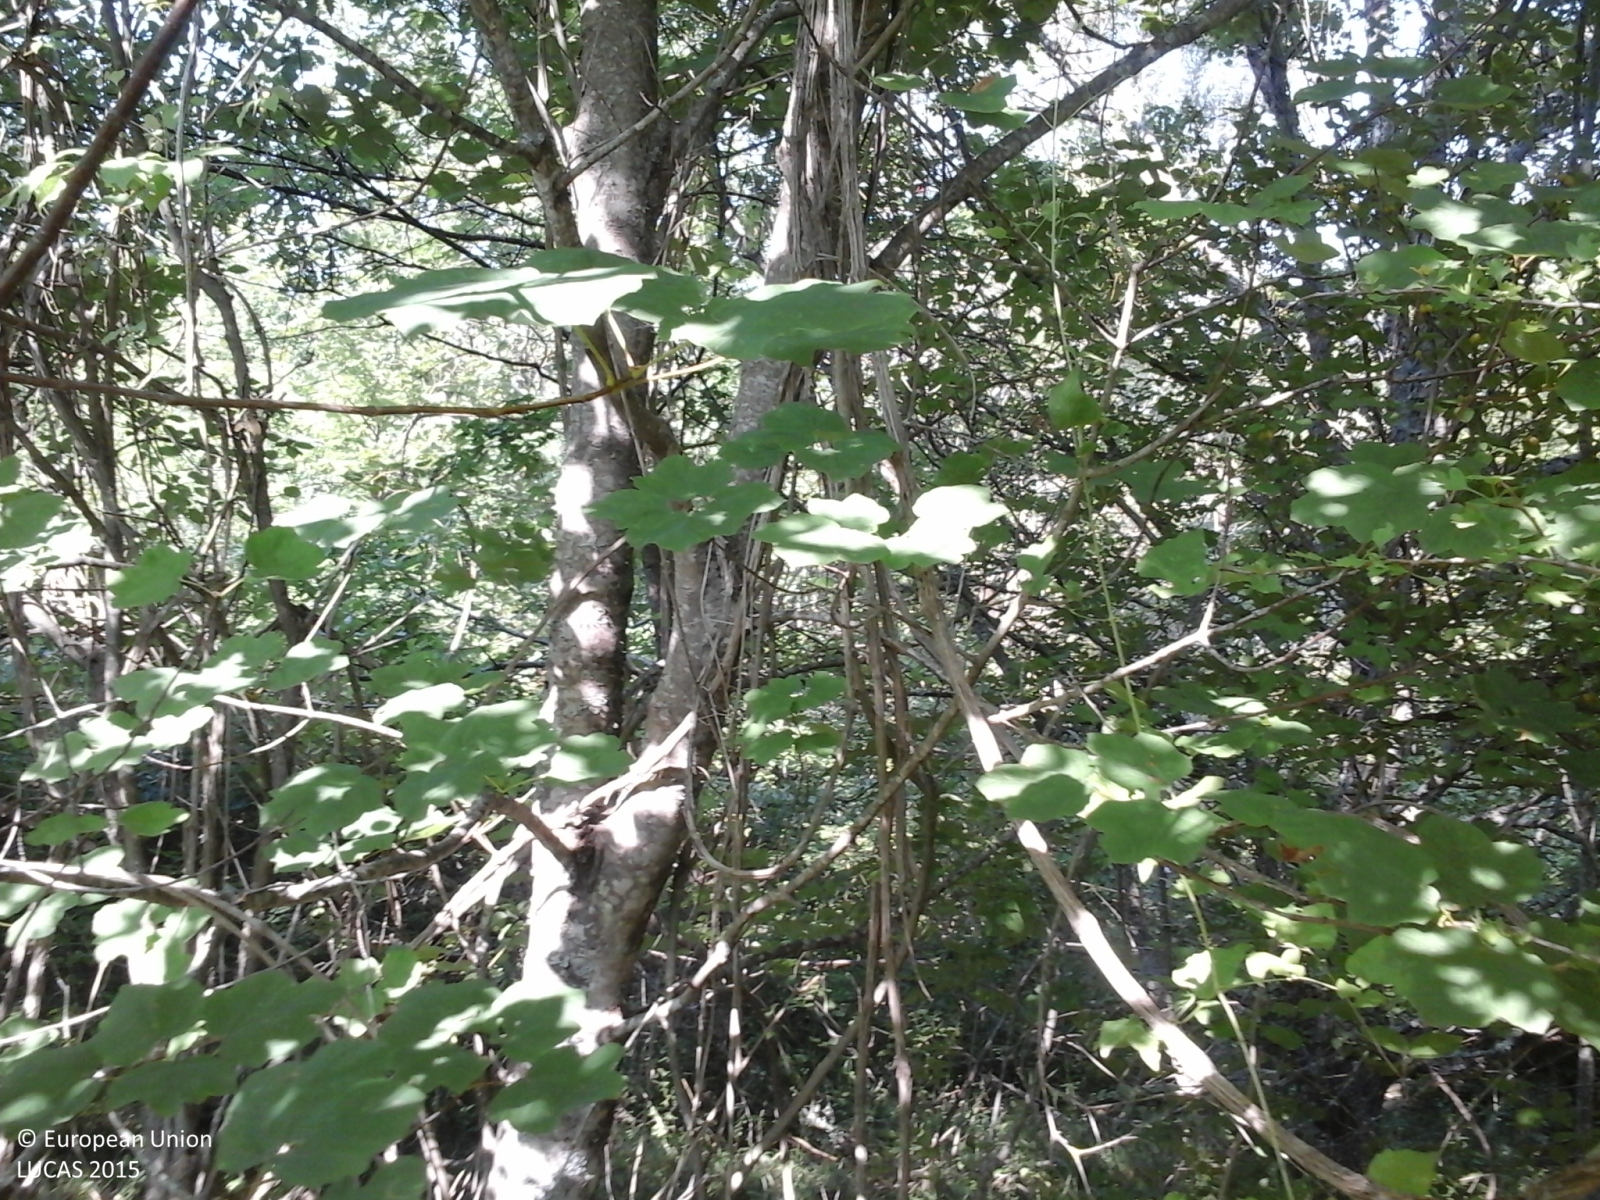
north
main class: Woodland
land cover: Broadleaved woodland
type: thermophilous deciduous forest
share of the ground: > 75 %
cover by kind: broadleaved forest trees 100 %
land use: Forestry
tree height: > 5 m
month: August
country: IT
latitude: 43.6204
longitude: 12.3361
